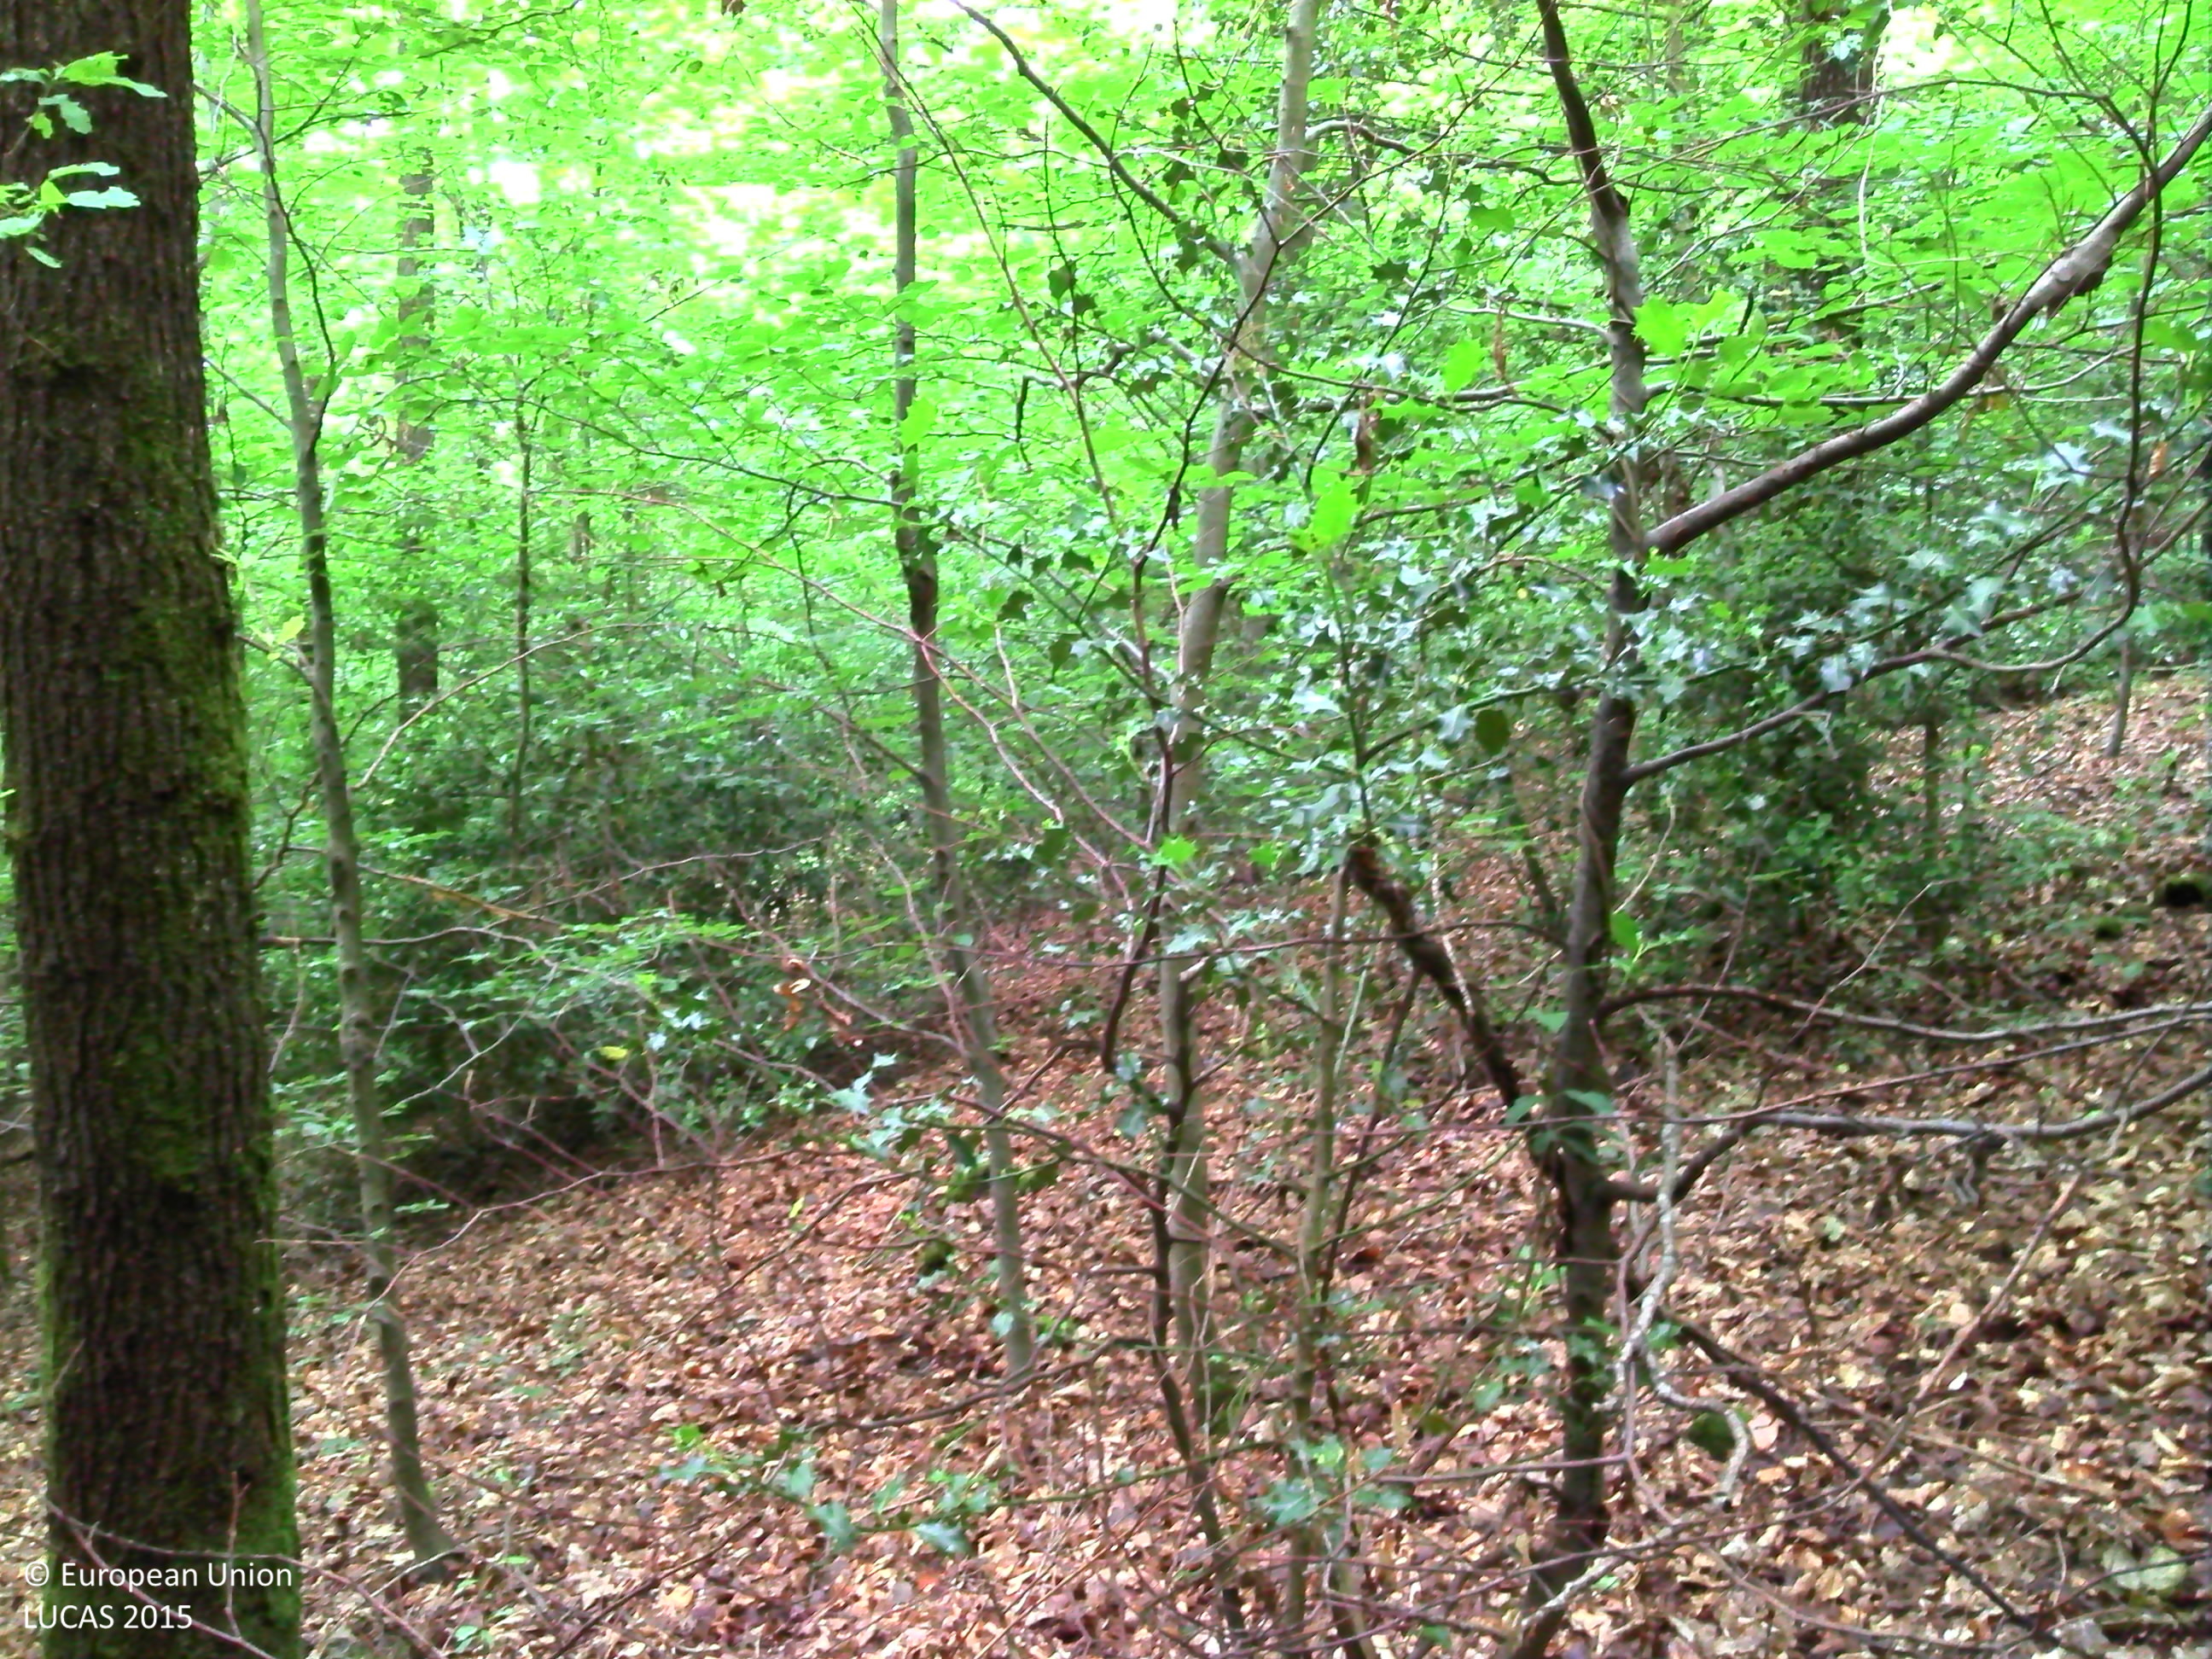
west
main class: Woodland
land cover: Broadleaved woodland
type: acidophilous oak and oak-birch forest
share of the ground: > 75 %
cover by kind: broadleaved forest trees 95 %, herbaceous plants 5 %
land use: Forestry
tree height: > 5 m
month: June
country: BE
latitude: 50.4074
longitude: 5.6506
